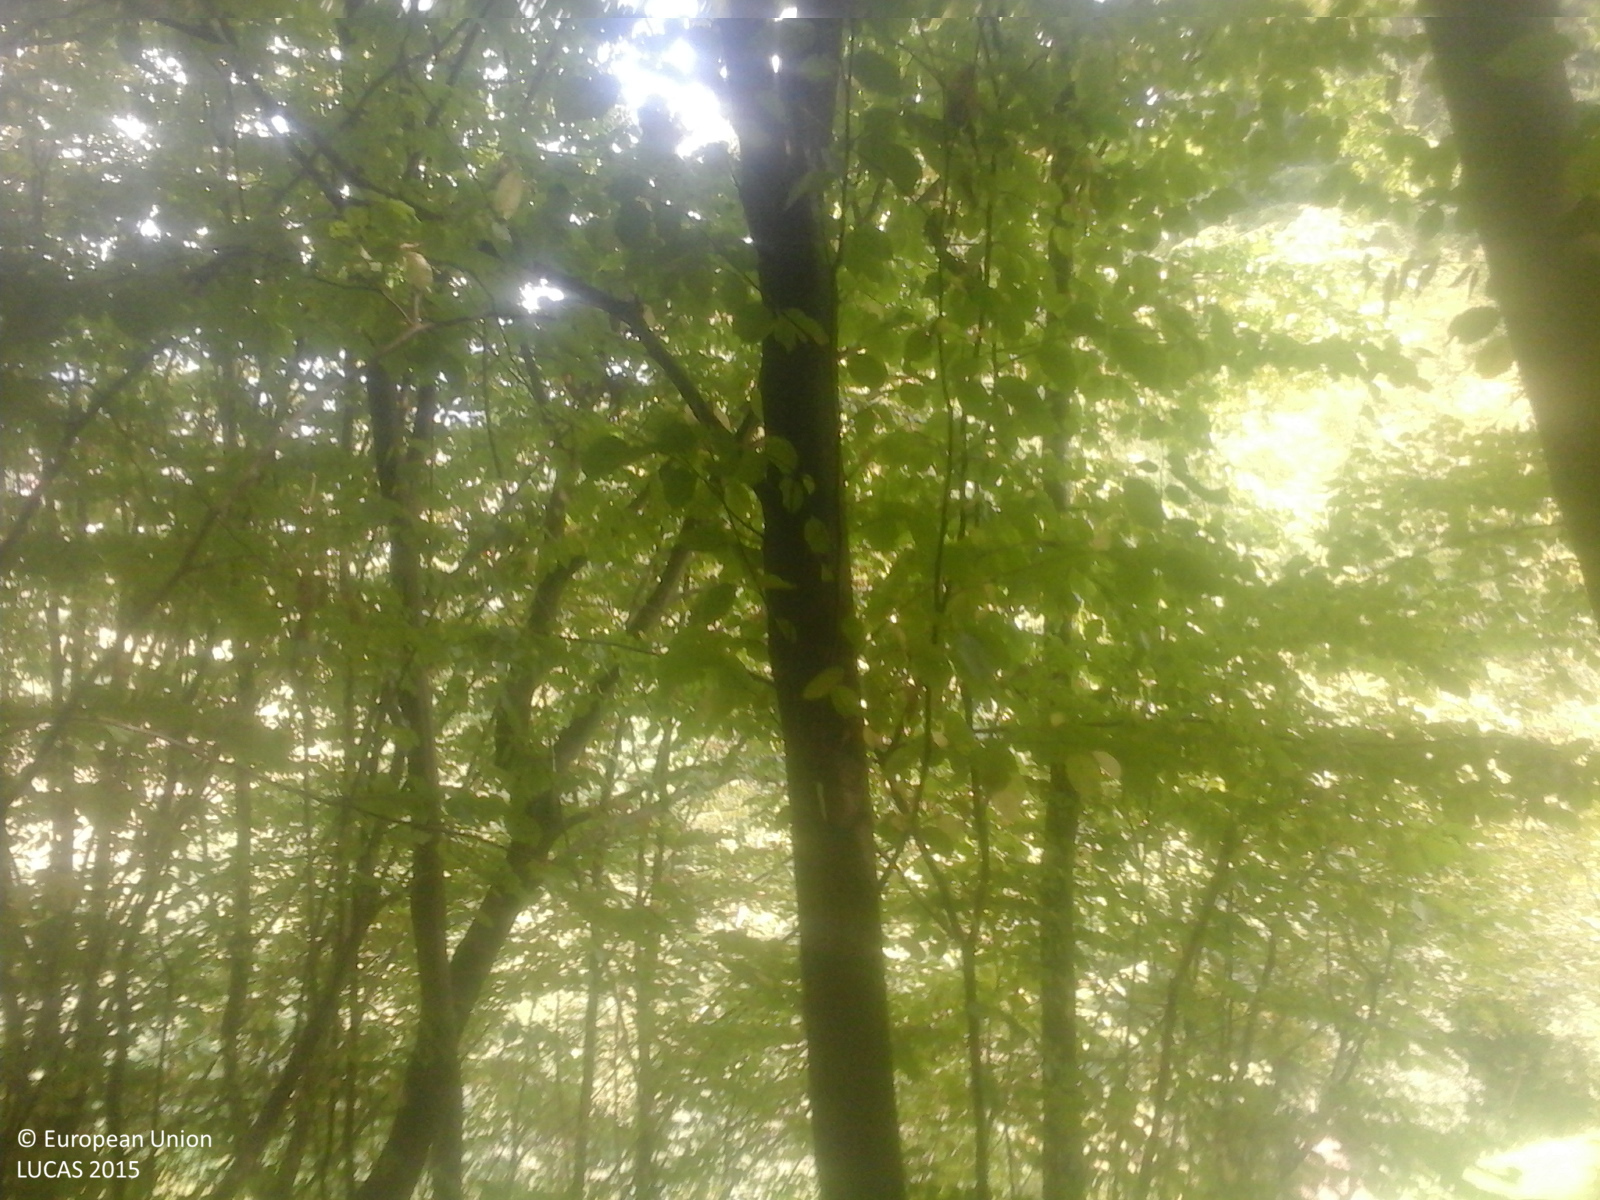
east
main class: Woodland
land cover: Broadleaved woodland
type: beech forest
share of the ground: > 75 %
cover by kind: broadleaved forest trees 100 %
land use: Forestry
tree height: > 5 m
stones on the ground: < 10 %
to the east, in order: Broadleaved woodland; Grassland without tree/shrub cover; Abandoned hedges; Ditches and canals; Abandoned hedges; Grassland without tree/shrub cover; Broadleaved woodland; Grassland without tree/shrub cover
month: September
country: RO
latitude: 47.7112
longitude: 24.3941
